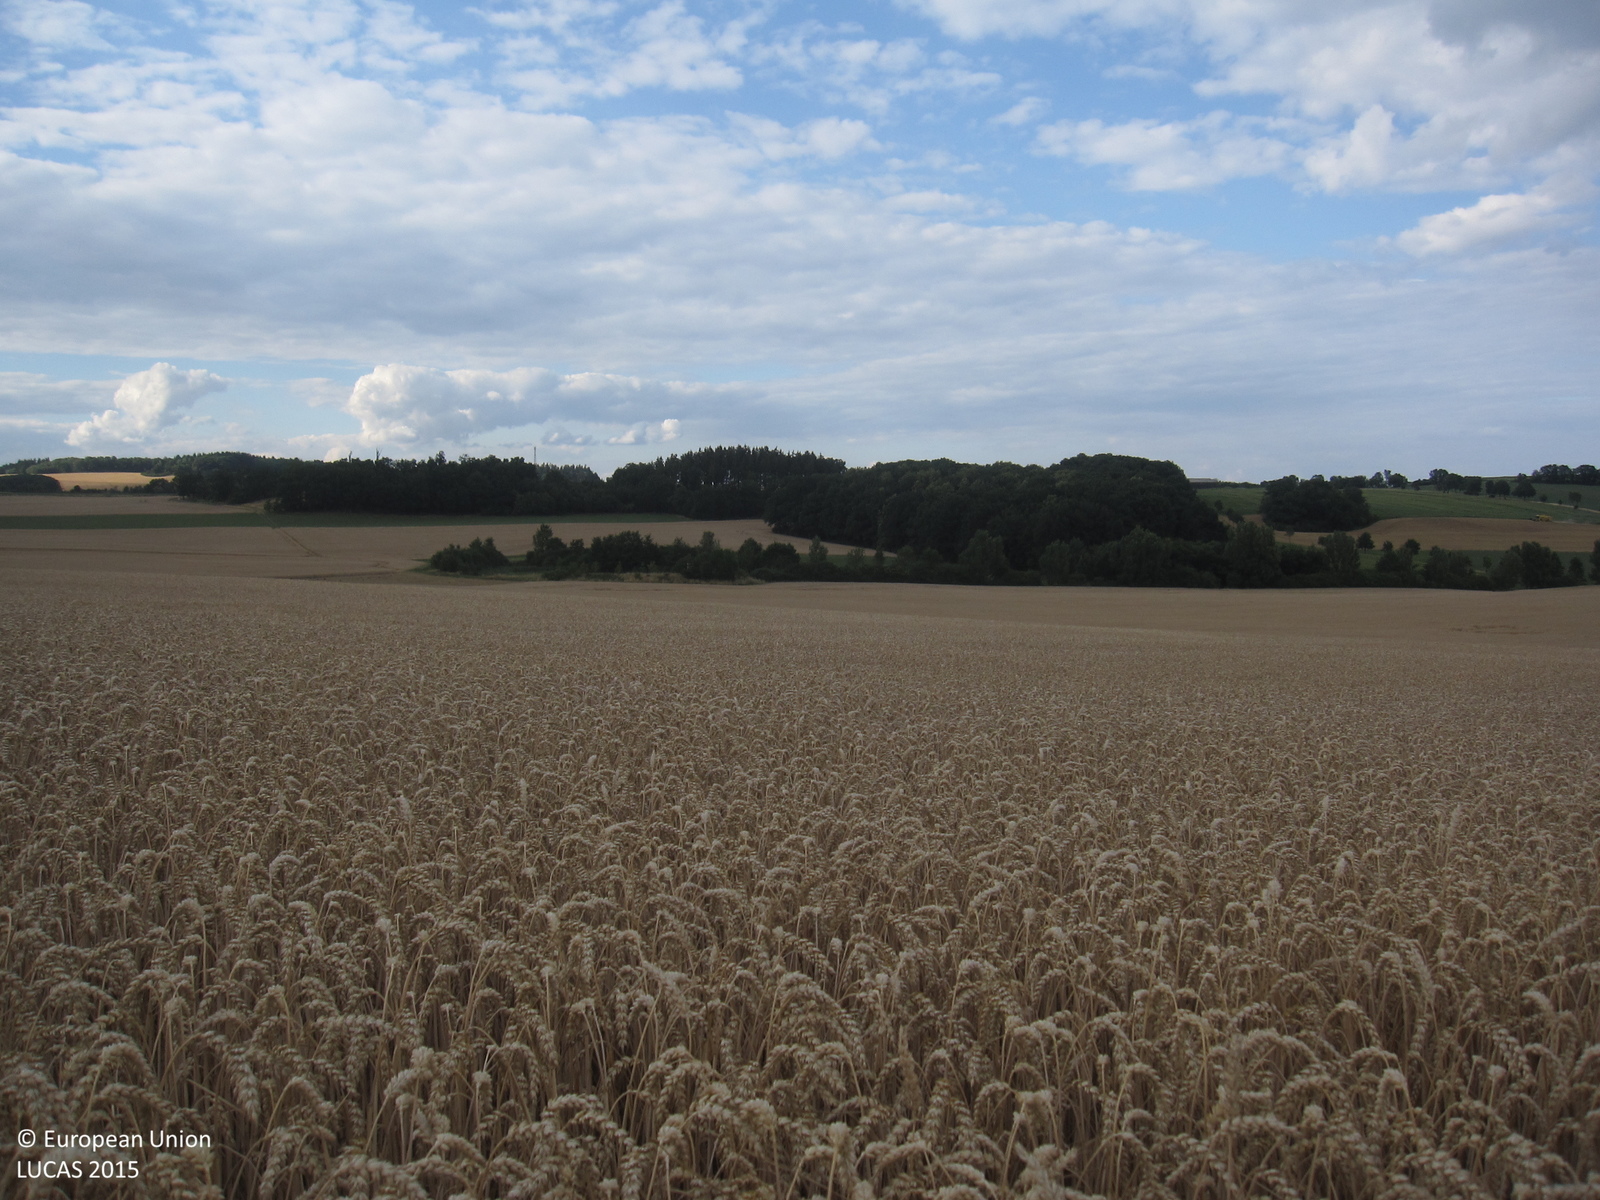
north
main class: Cropland
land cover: Common wheat
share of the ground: > 75 %
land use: Agriculture (excluding fallow land and kitchen gardens)
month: July
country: DE
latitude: 50.4727
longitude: 11.9863
